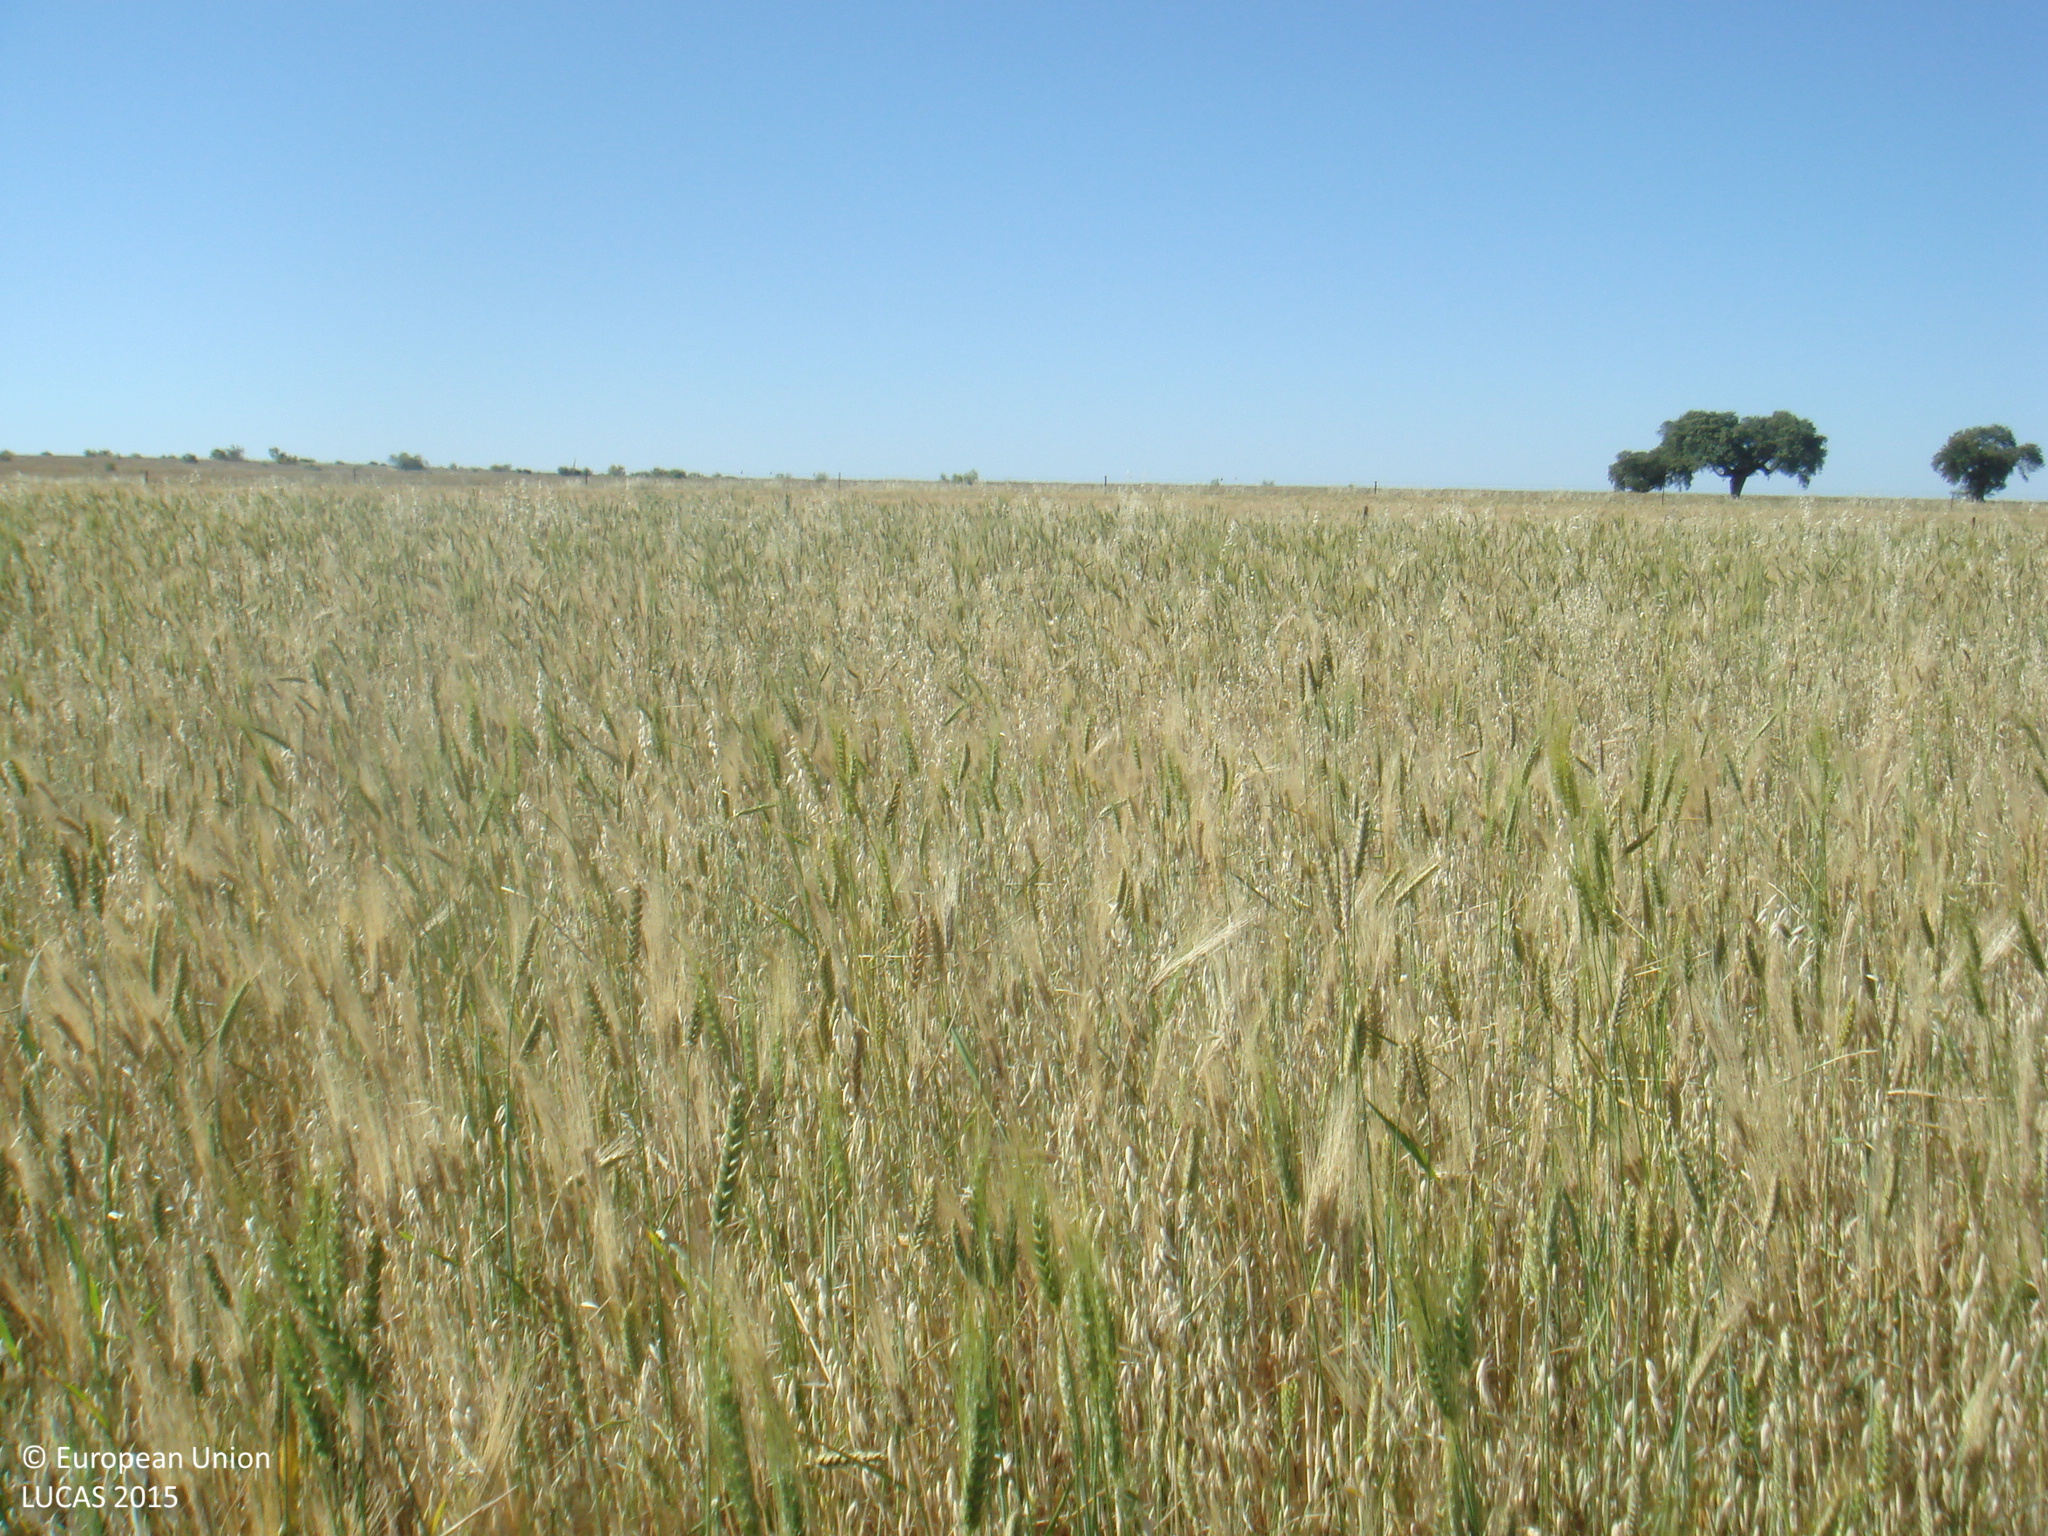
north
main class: Cropland
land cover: Mixed cereals for fodder
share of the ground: > 75 %
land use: Agriculture (excluding fallow land and kitchen gardens)
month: May
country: ES
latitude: 38.5372
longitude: -5.1160
